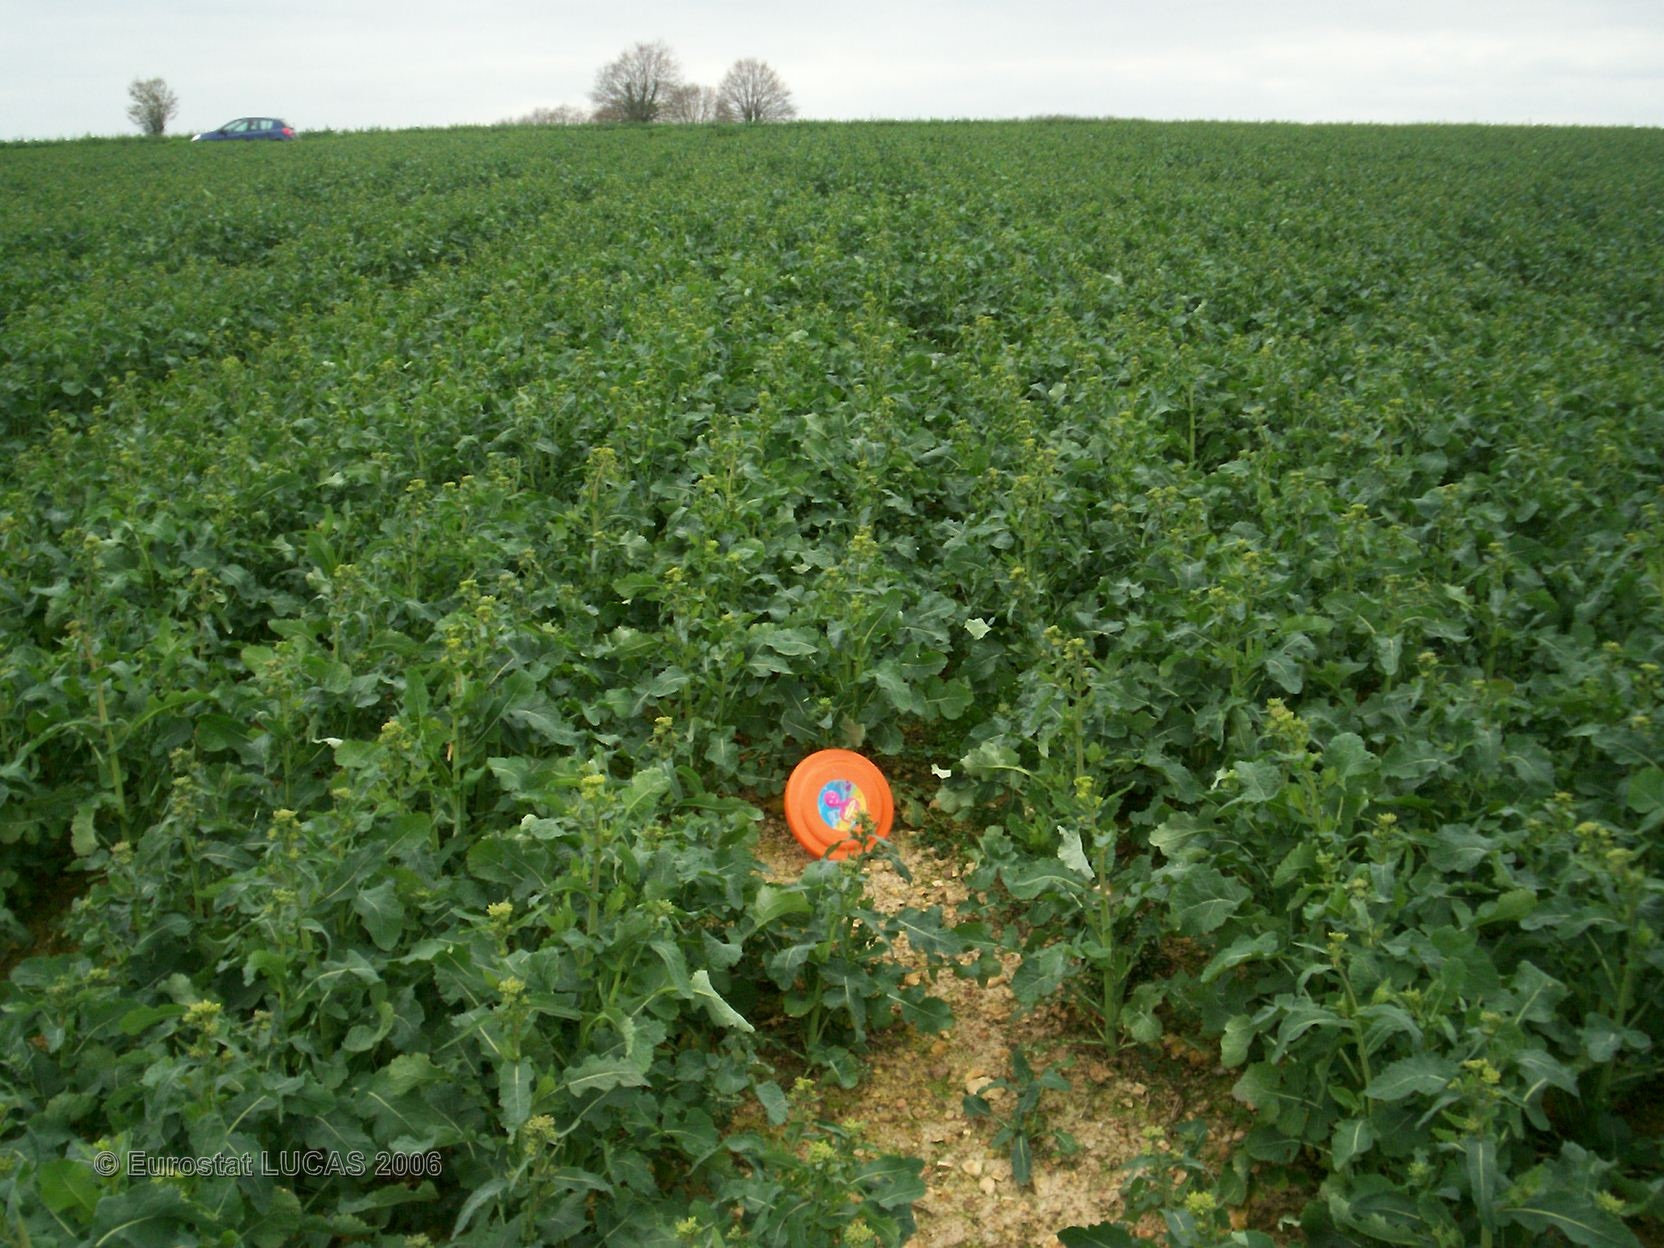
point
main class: Cropland
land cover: Rape and turnip rape
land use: Agriculture (excluding fallow land and kitchen gardens)
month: April
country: FR
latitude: 47.9096
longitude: 0.7879
